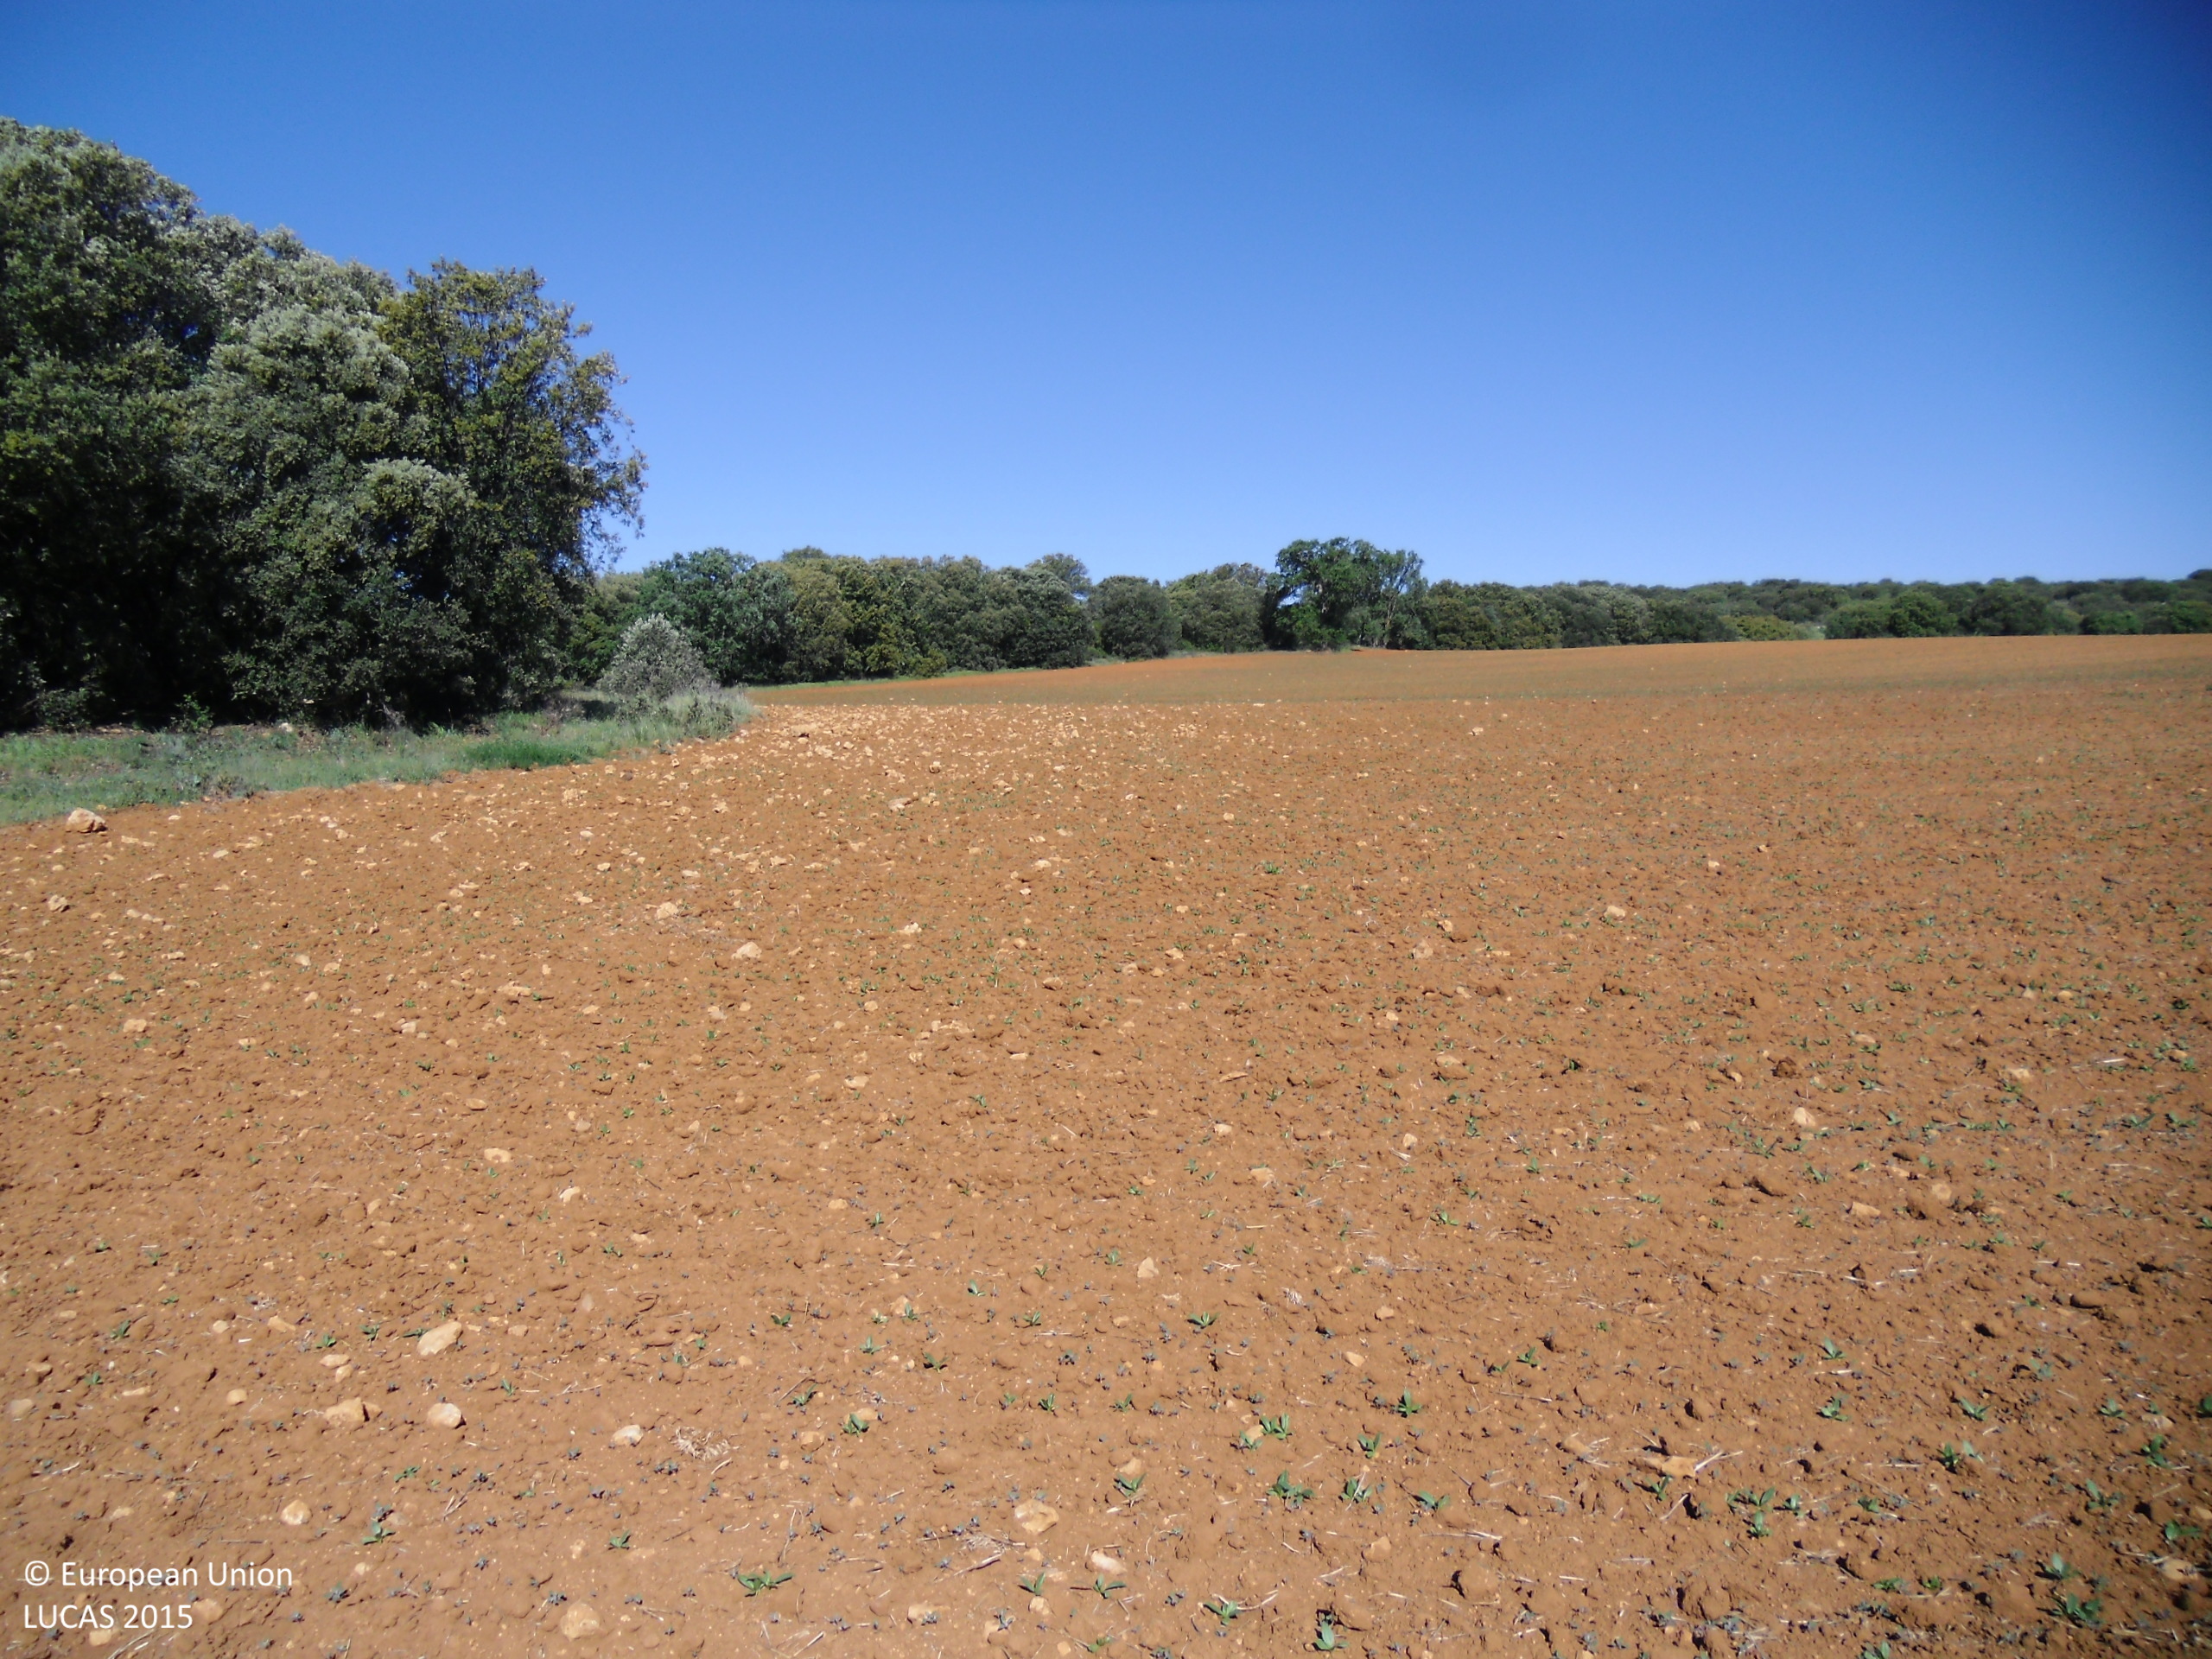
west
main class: Cropland
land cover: Soya
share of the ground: < 10 %
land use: Agriculture (excluding fallow land and kitchen gardens)
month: May
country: ES
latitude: 40.2031
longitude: -2.8654
